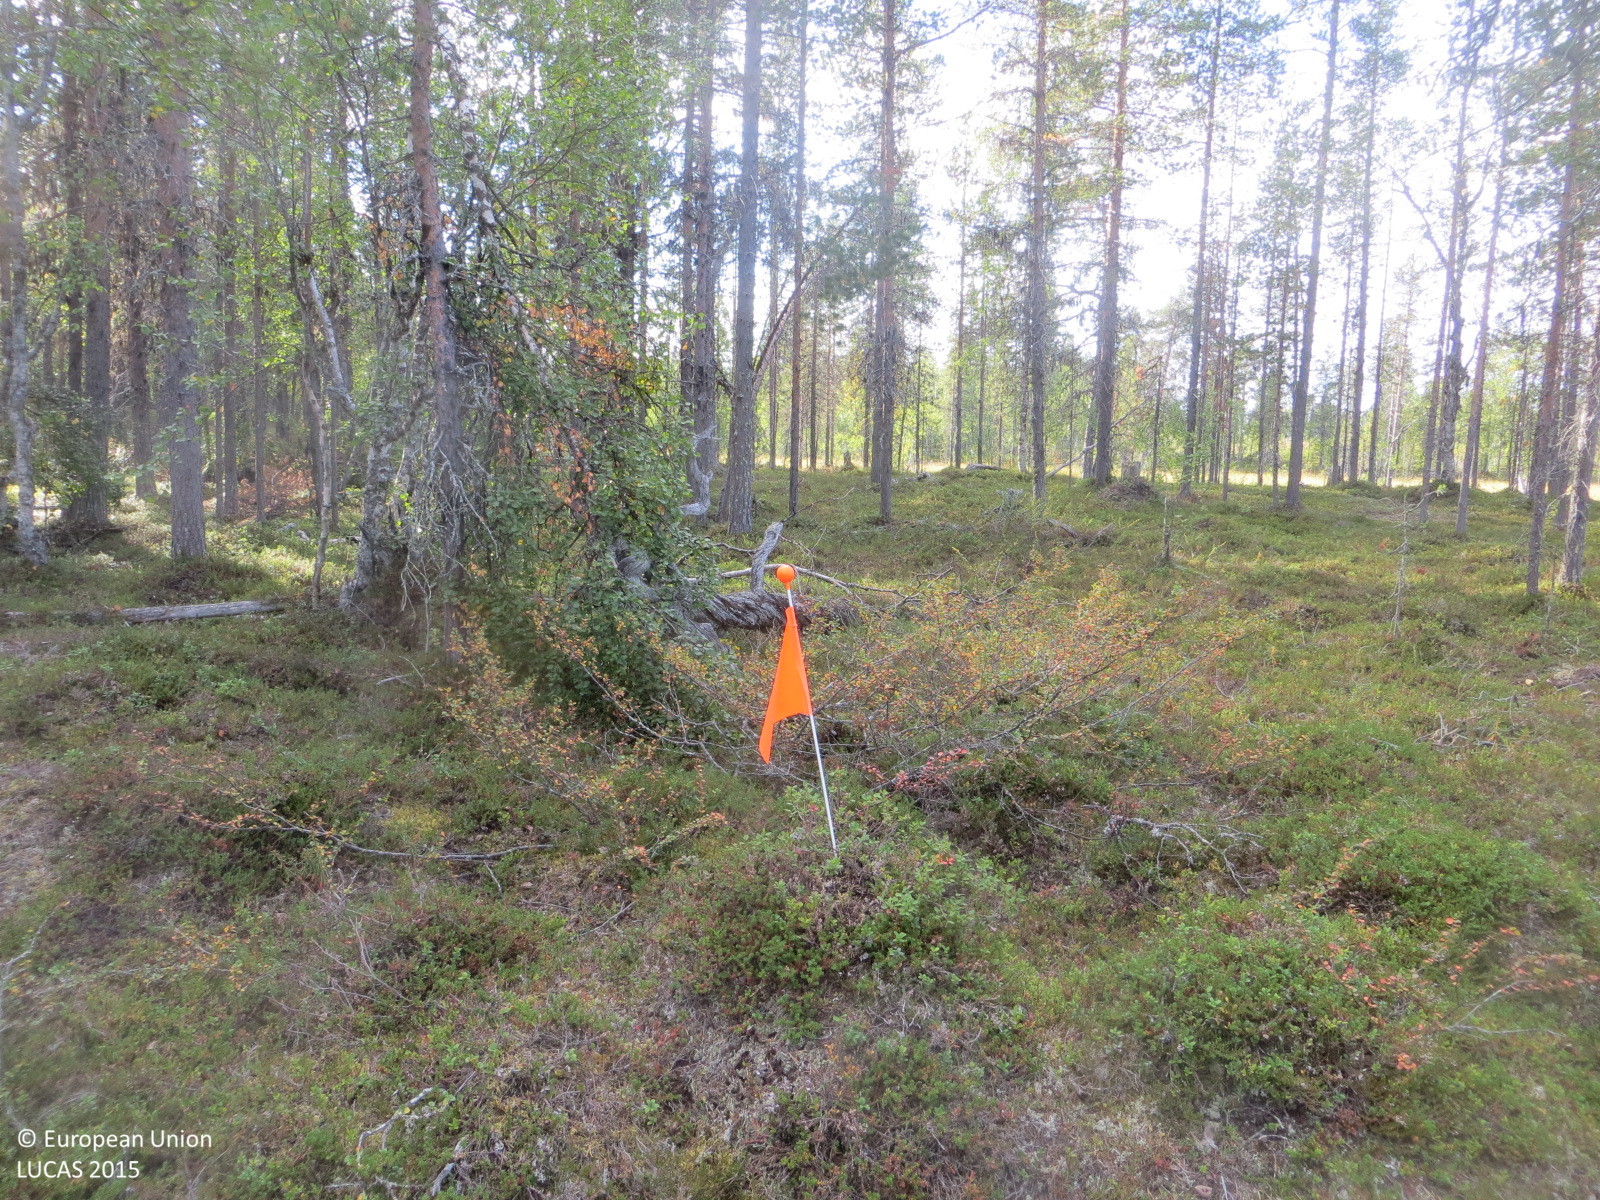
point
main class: Woodland
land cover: Pine dominated coniferous woodland
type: boreal forest
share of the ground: 50 - 75 %
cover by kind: shrubs 50 %, coniferous forest trees 45 %, broadleaved forest trees 5 %
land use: Forestry
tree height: > 5 m
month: August
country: FI
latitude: 68.2123
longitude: 25.6610
